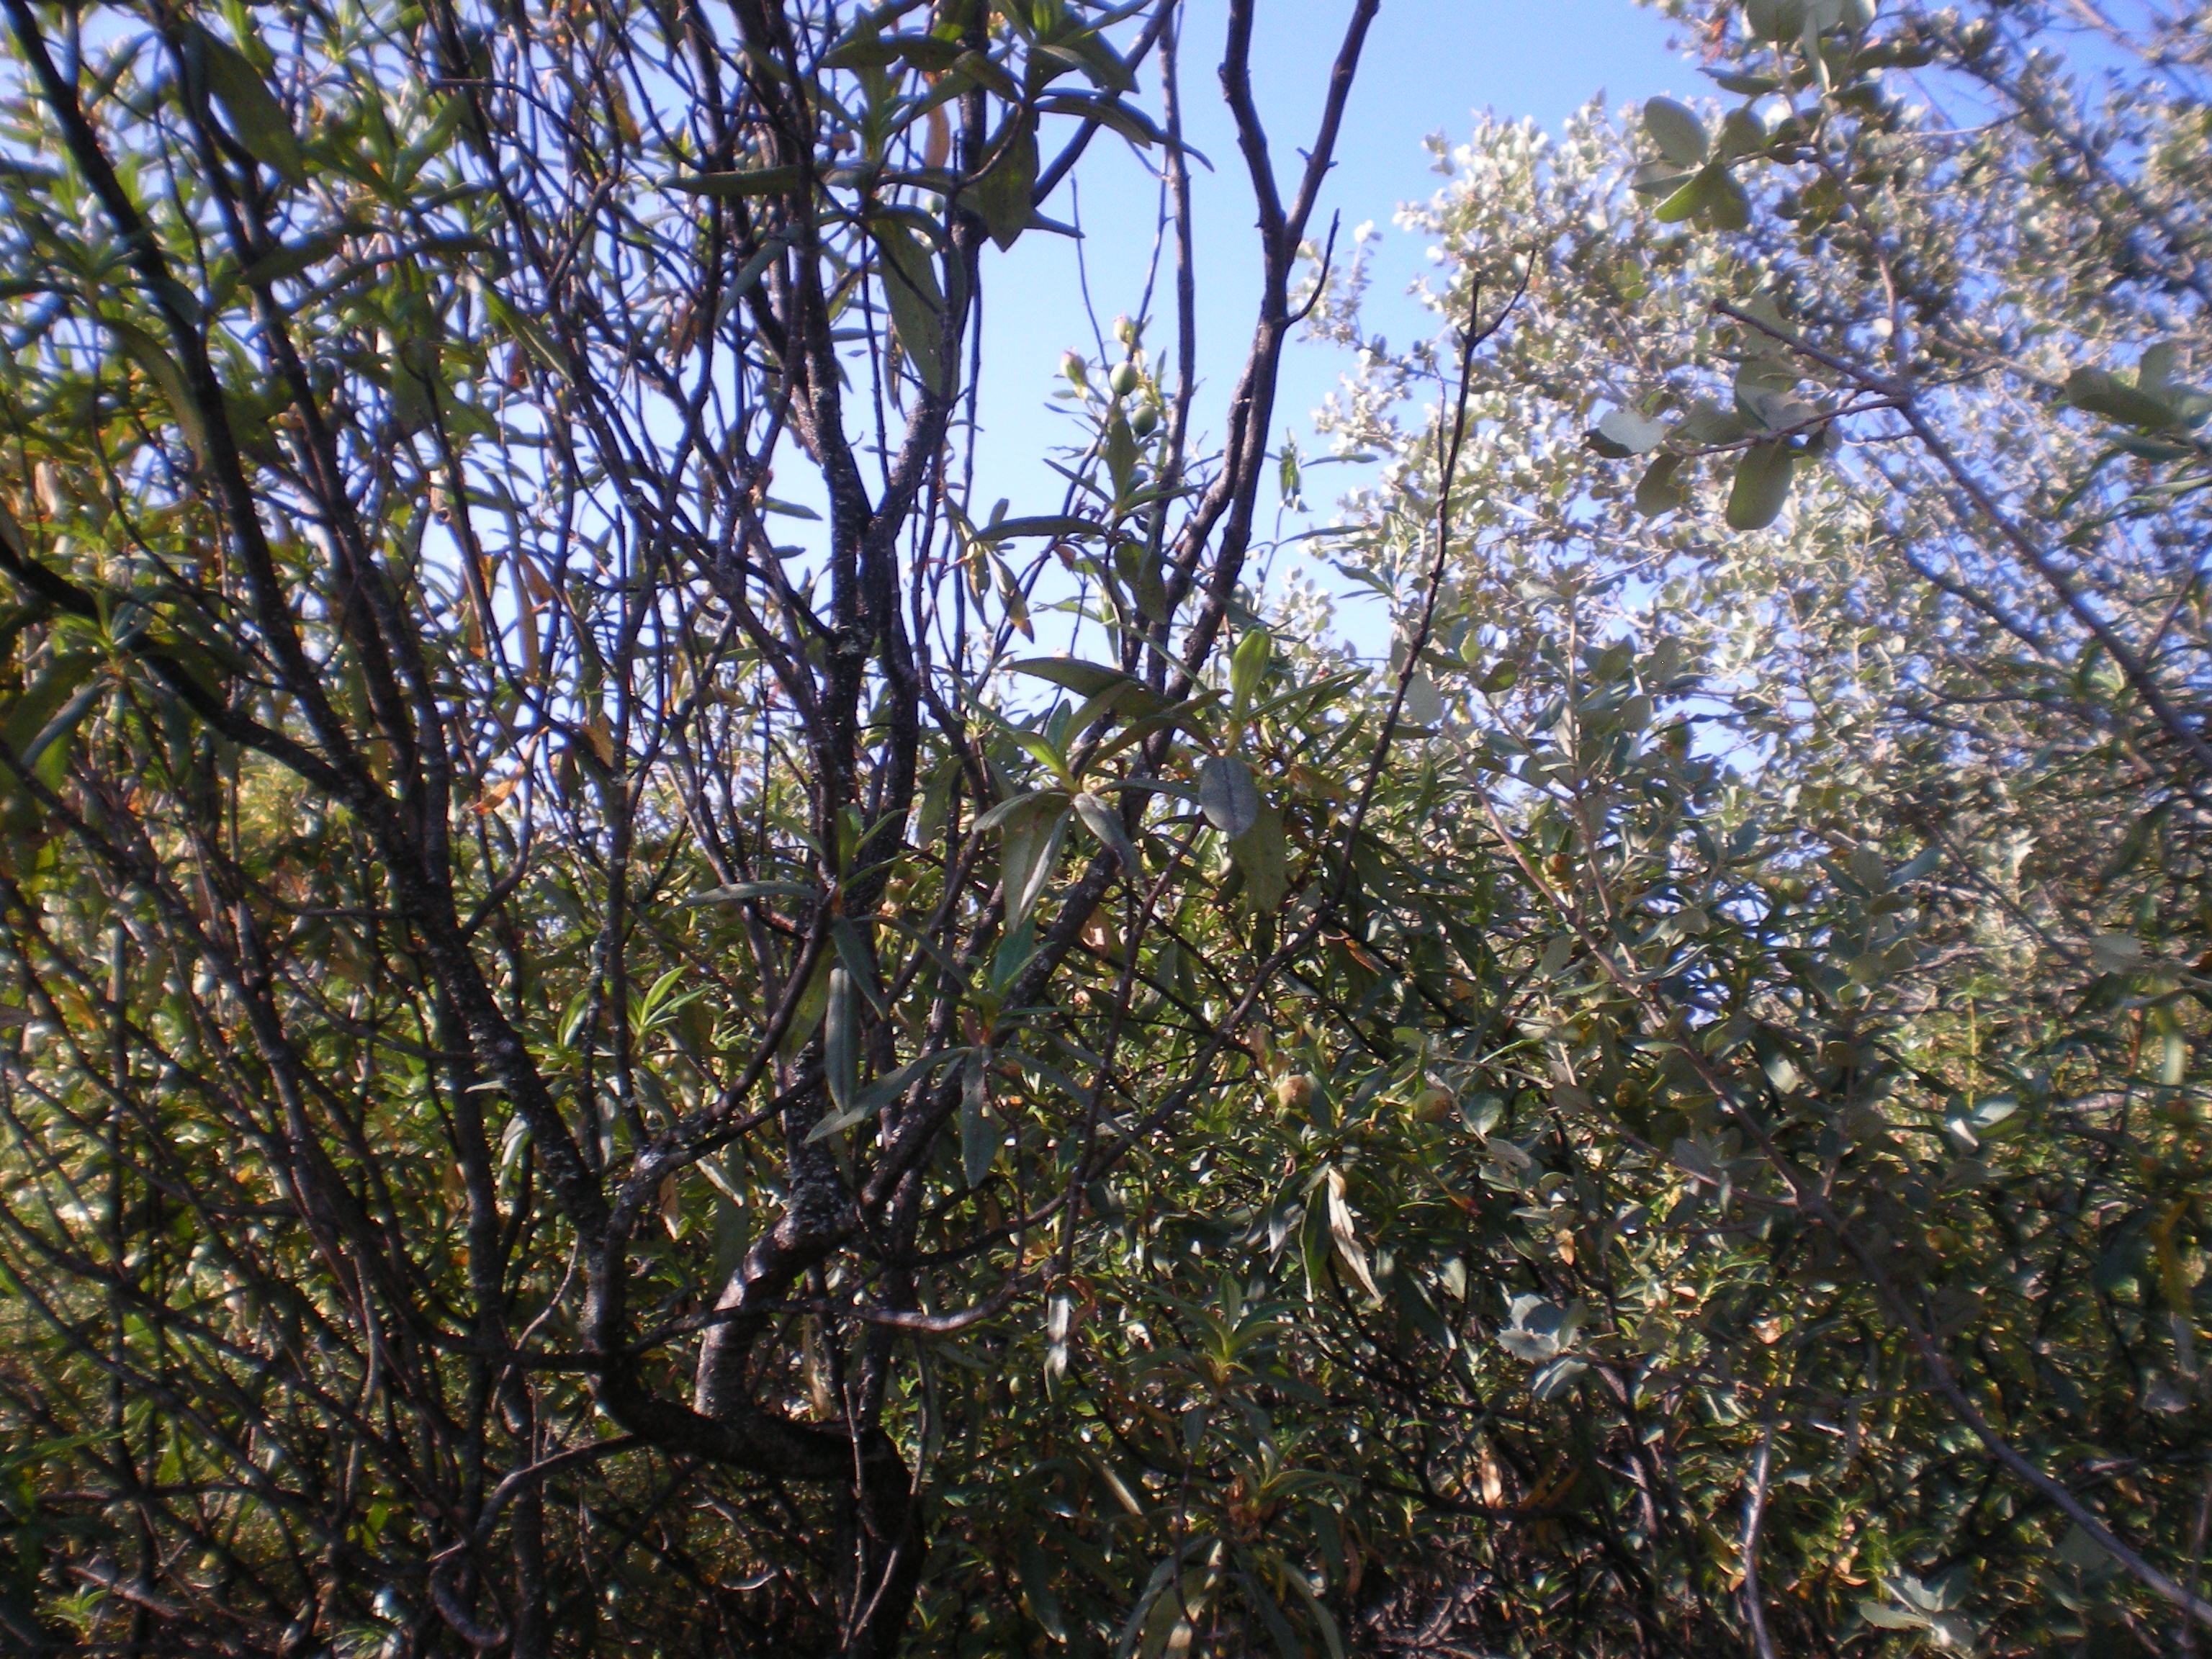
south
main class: Woodland
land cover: Broadleaved woodland
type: broadleaved evergreen forest
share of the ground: > 75 %
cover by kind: shrubs 70 %, broadleaved forest trees 15 %, unconsolidated bare surface 10 %, herbaceous plants 5 %
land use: Semi-natural and natural areas not in use
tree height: < 5 m
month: June
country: ES
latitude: 38.3984
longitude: -3.3450
